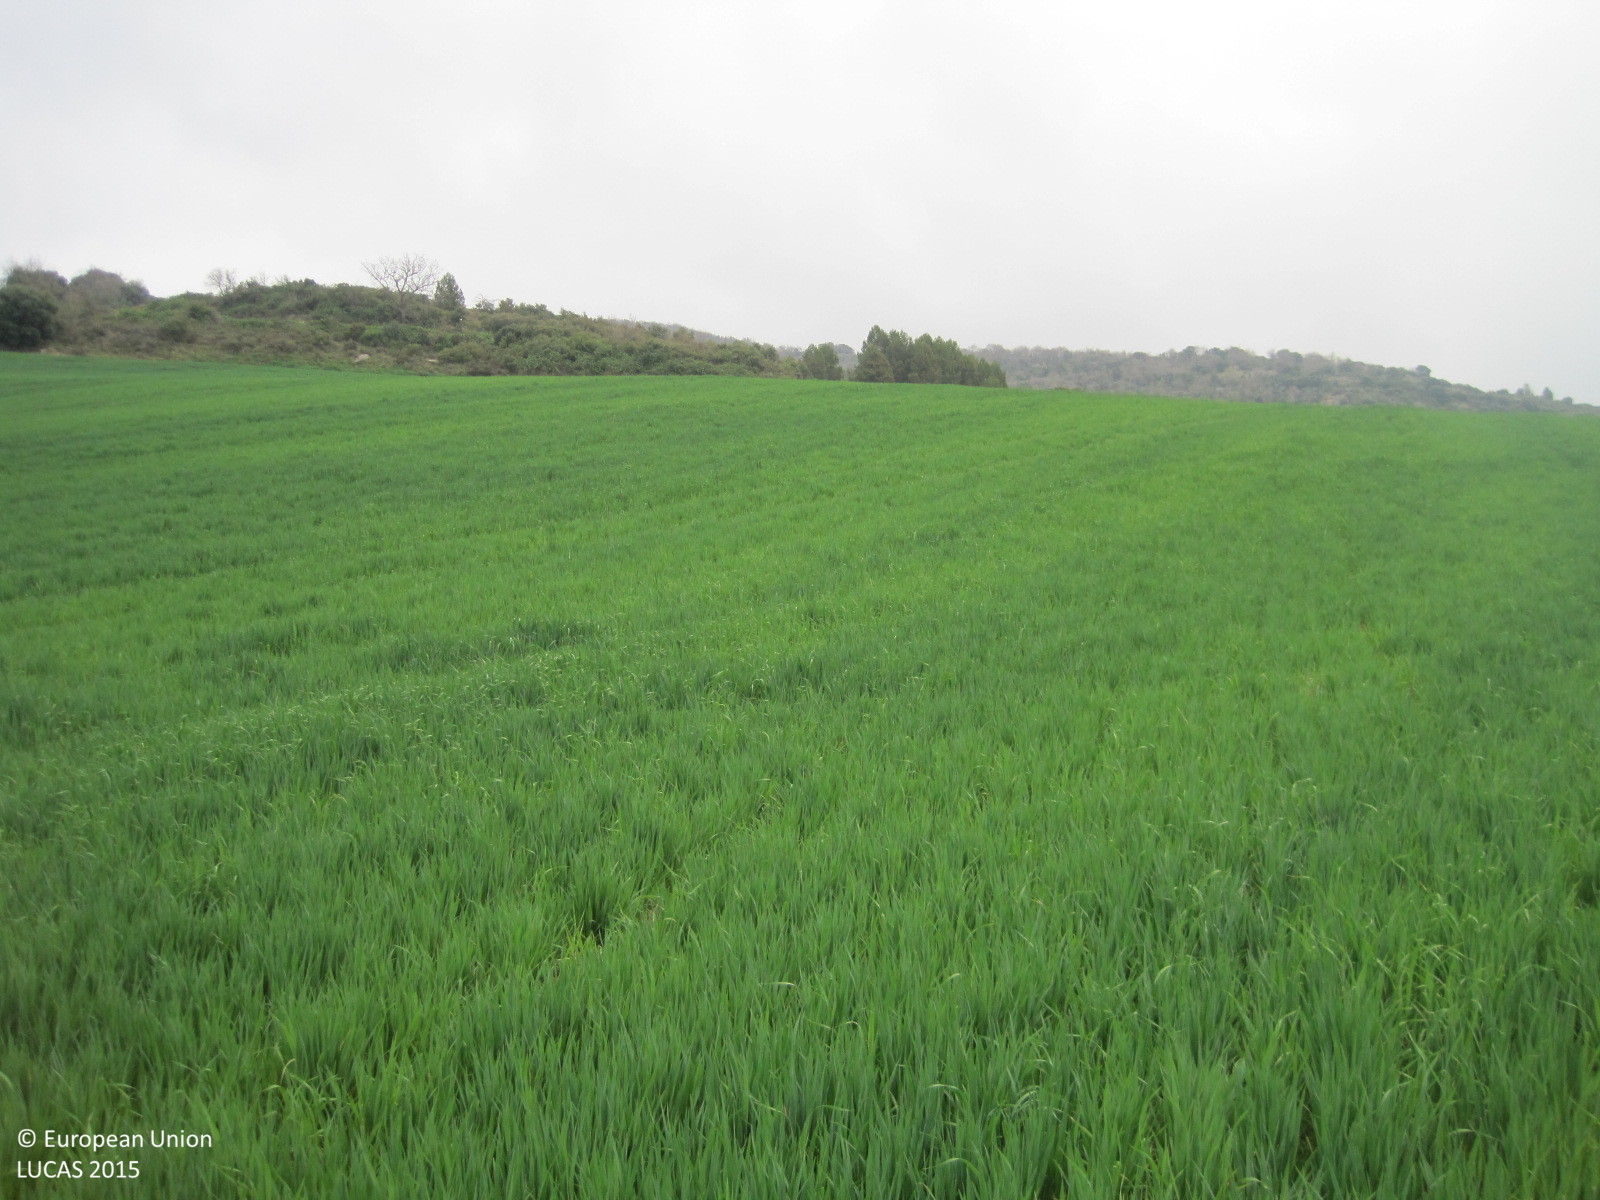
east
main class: Cropland
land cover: Rye
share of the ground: > 75 %
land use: Agriculture (excluding fallow land and kitchen gardens)
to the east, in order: Rye; Shrubland with sparse tree cover; Barley; Shrubland with sparse tree cover; Tracks; Shrubland with sparse tree cover; Barley
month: April
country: ES
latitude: 42.6338
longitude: -2.1275
